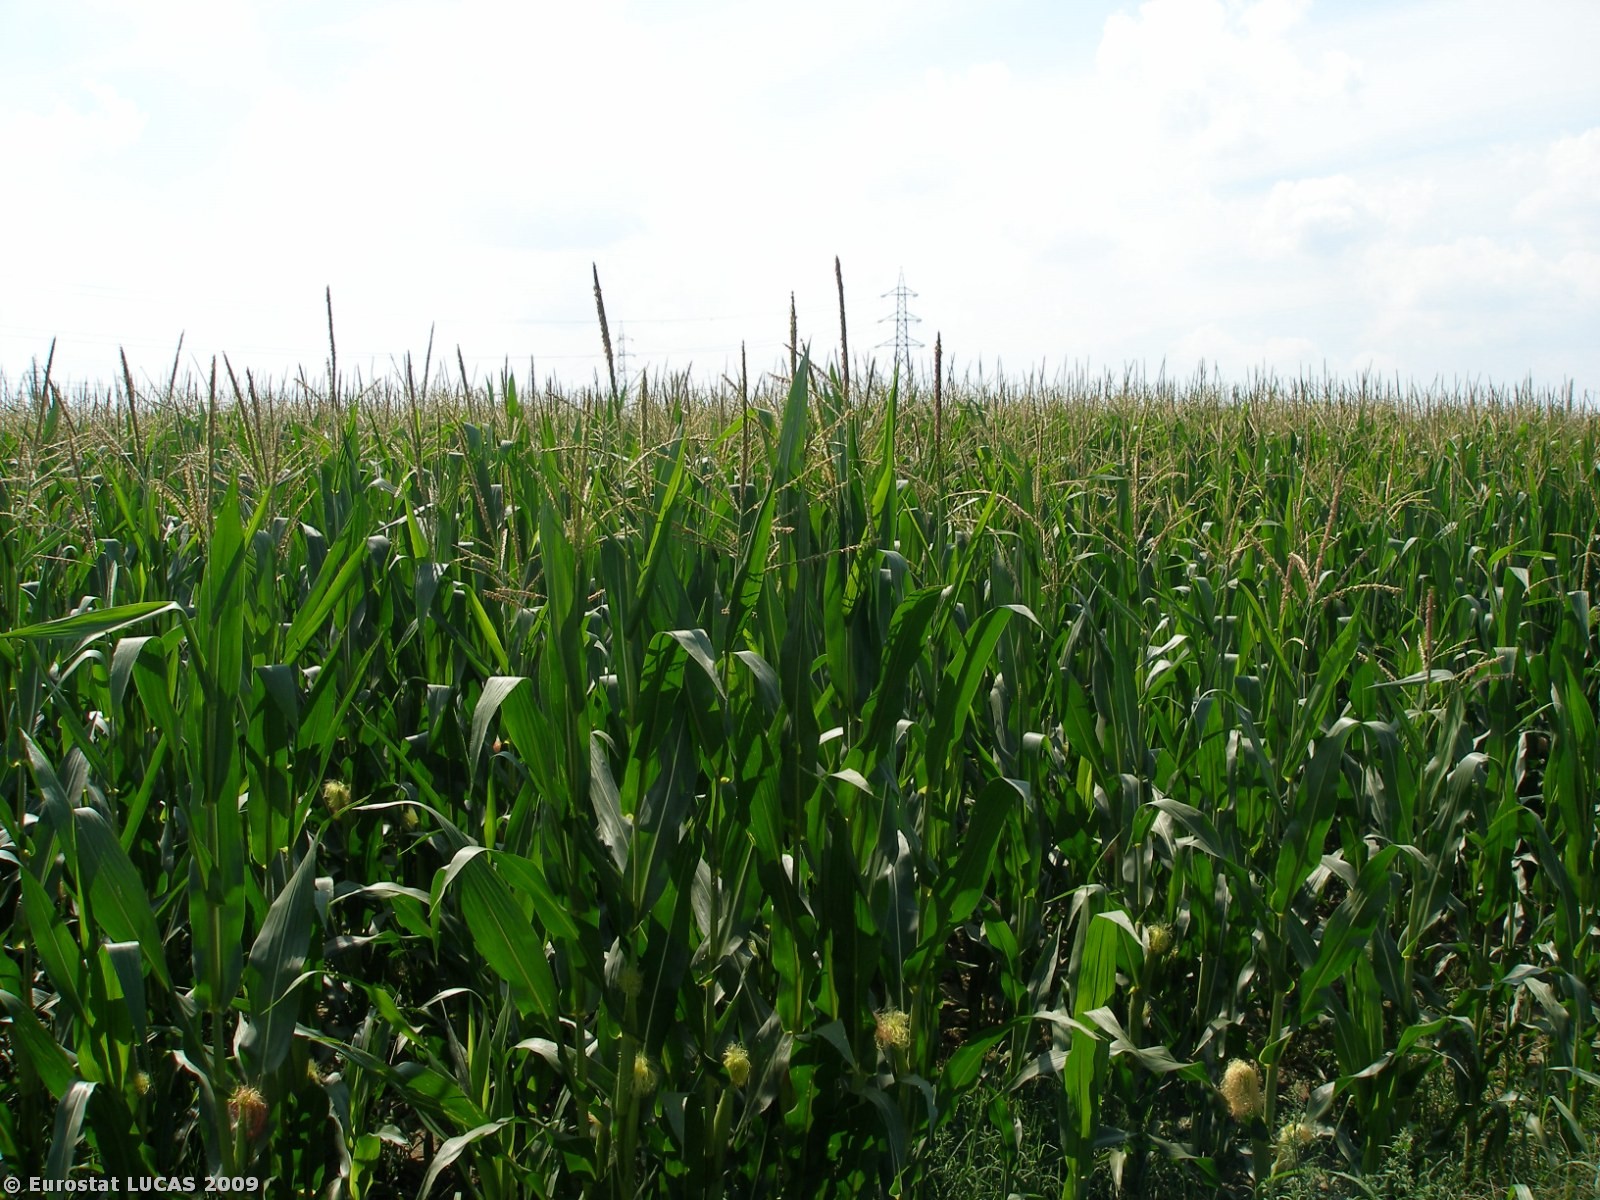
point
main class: Cropland
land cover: Maize
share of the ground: > 75 %
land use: Agriculture (excluding fallow land and kitchen gardens)
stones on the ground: < 10 %
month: July
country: IT
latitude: 45.0695
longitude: 12.0666
